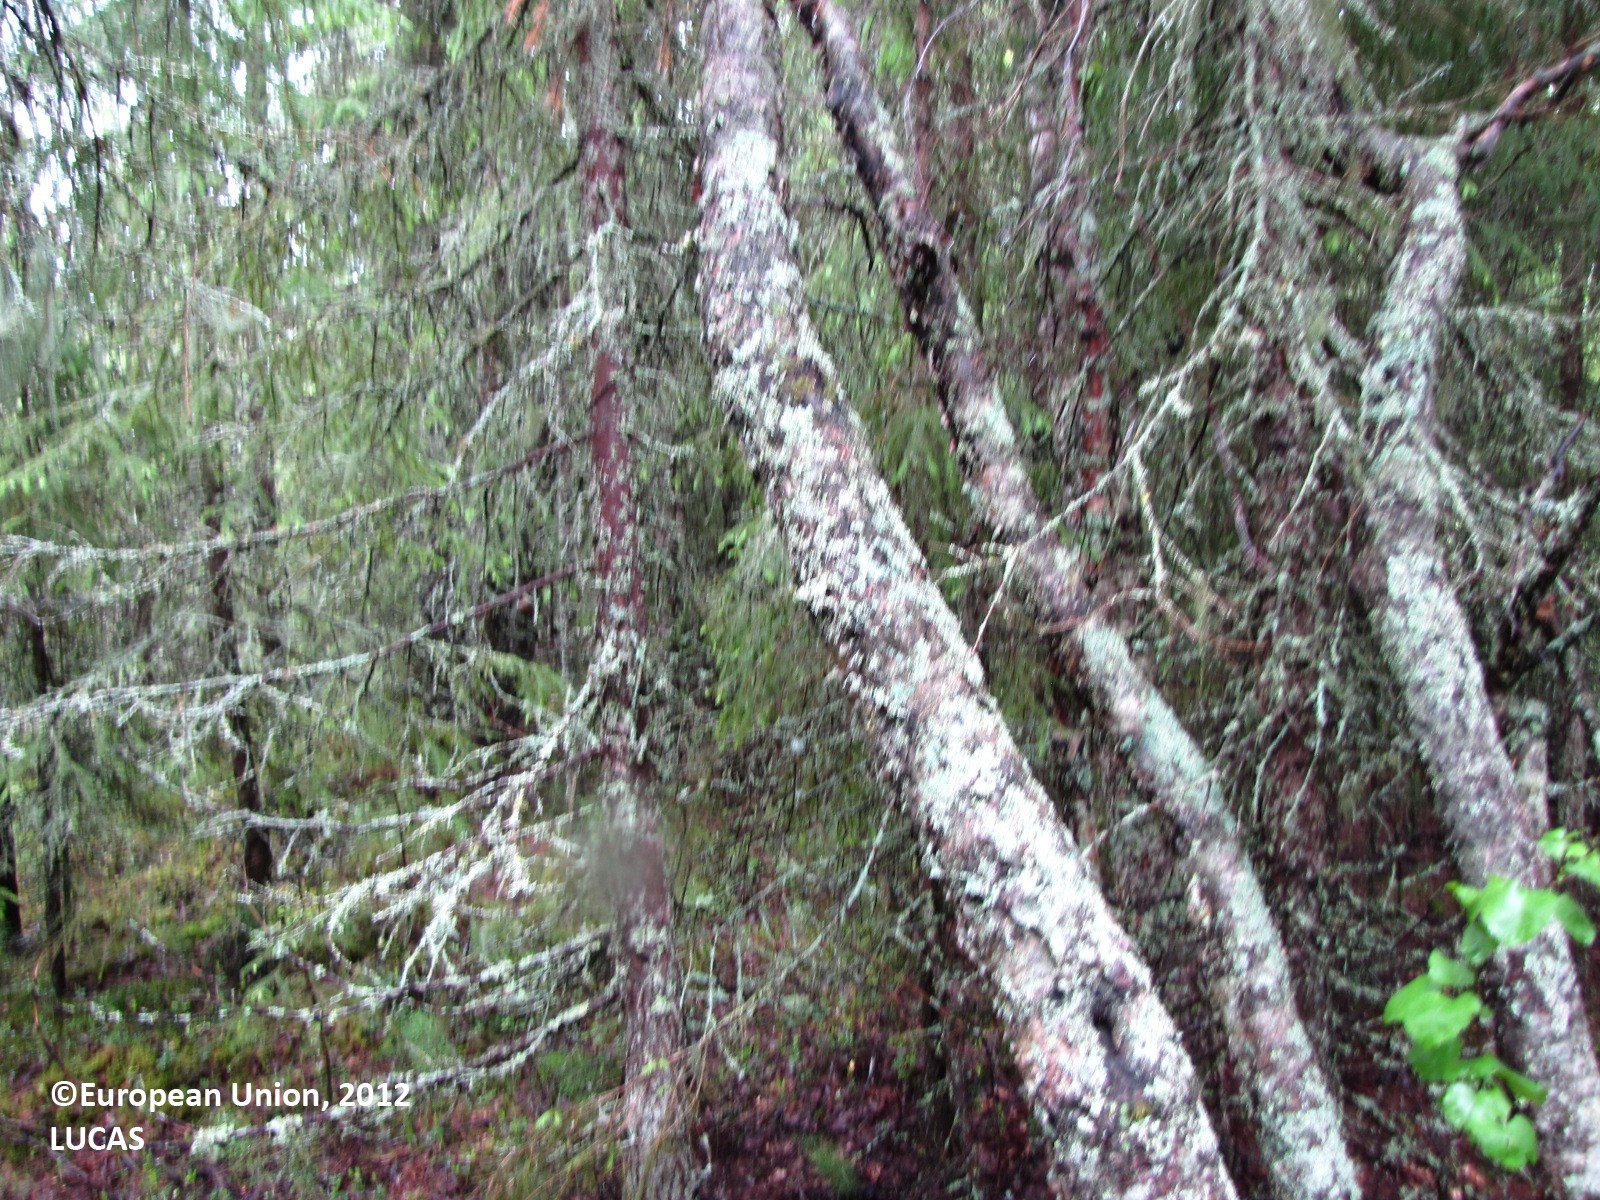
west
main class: Woodland
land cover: Spruce dominated coniferous woodland
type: boreal forest
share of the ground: 50 - 75 %
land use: Forestry
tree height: > 5 m
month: June
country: FI
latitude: 66.3692
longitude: 24.4659
